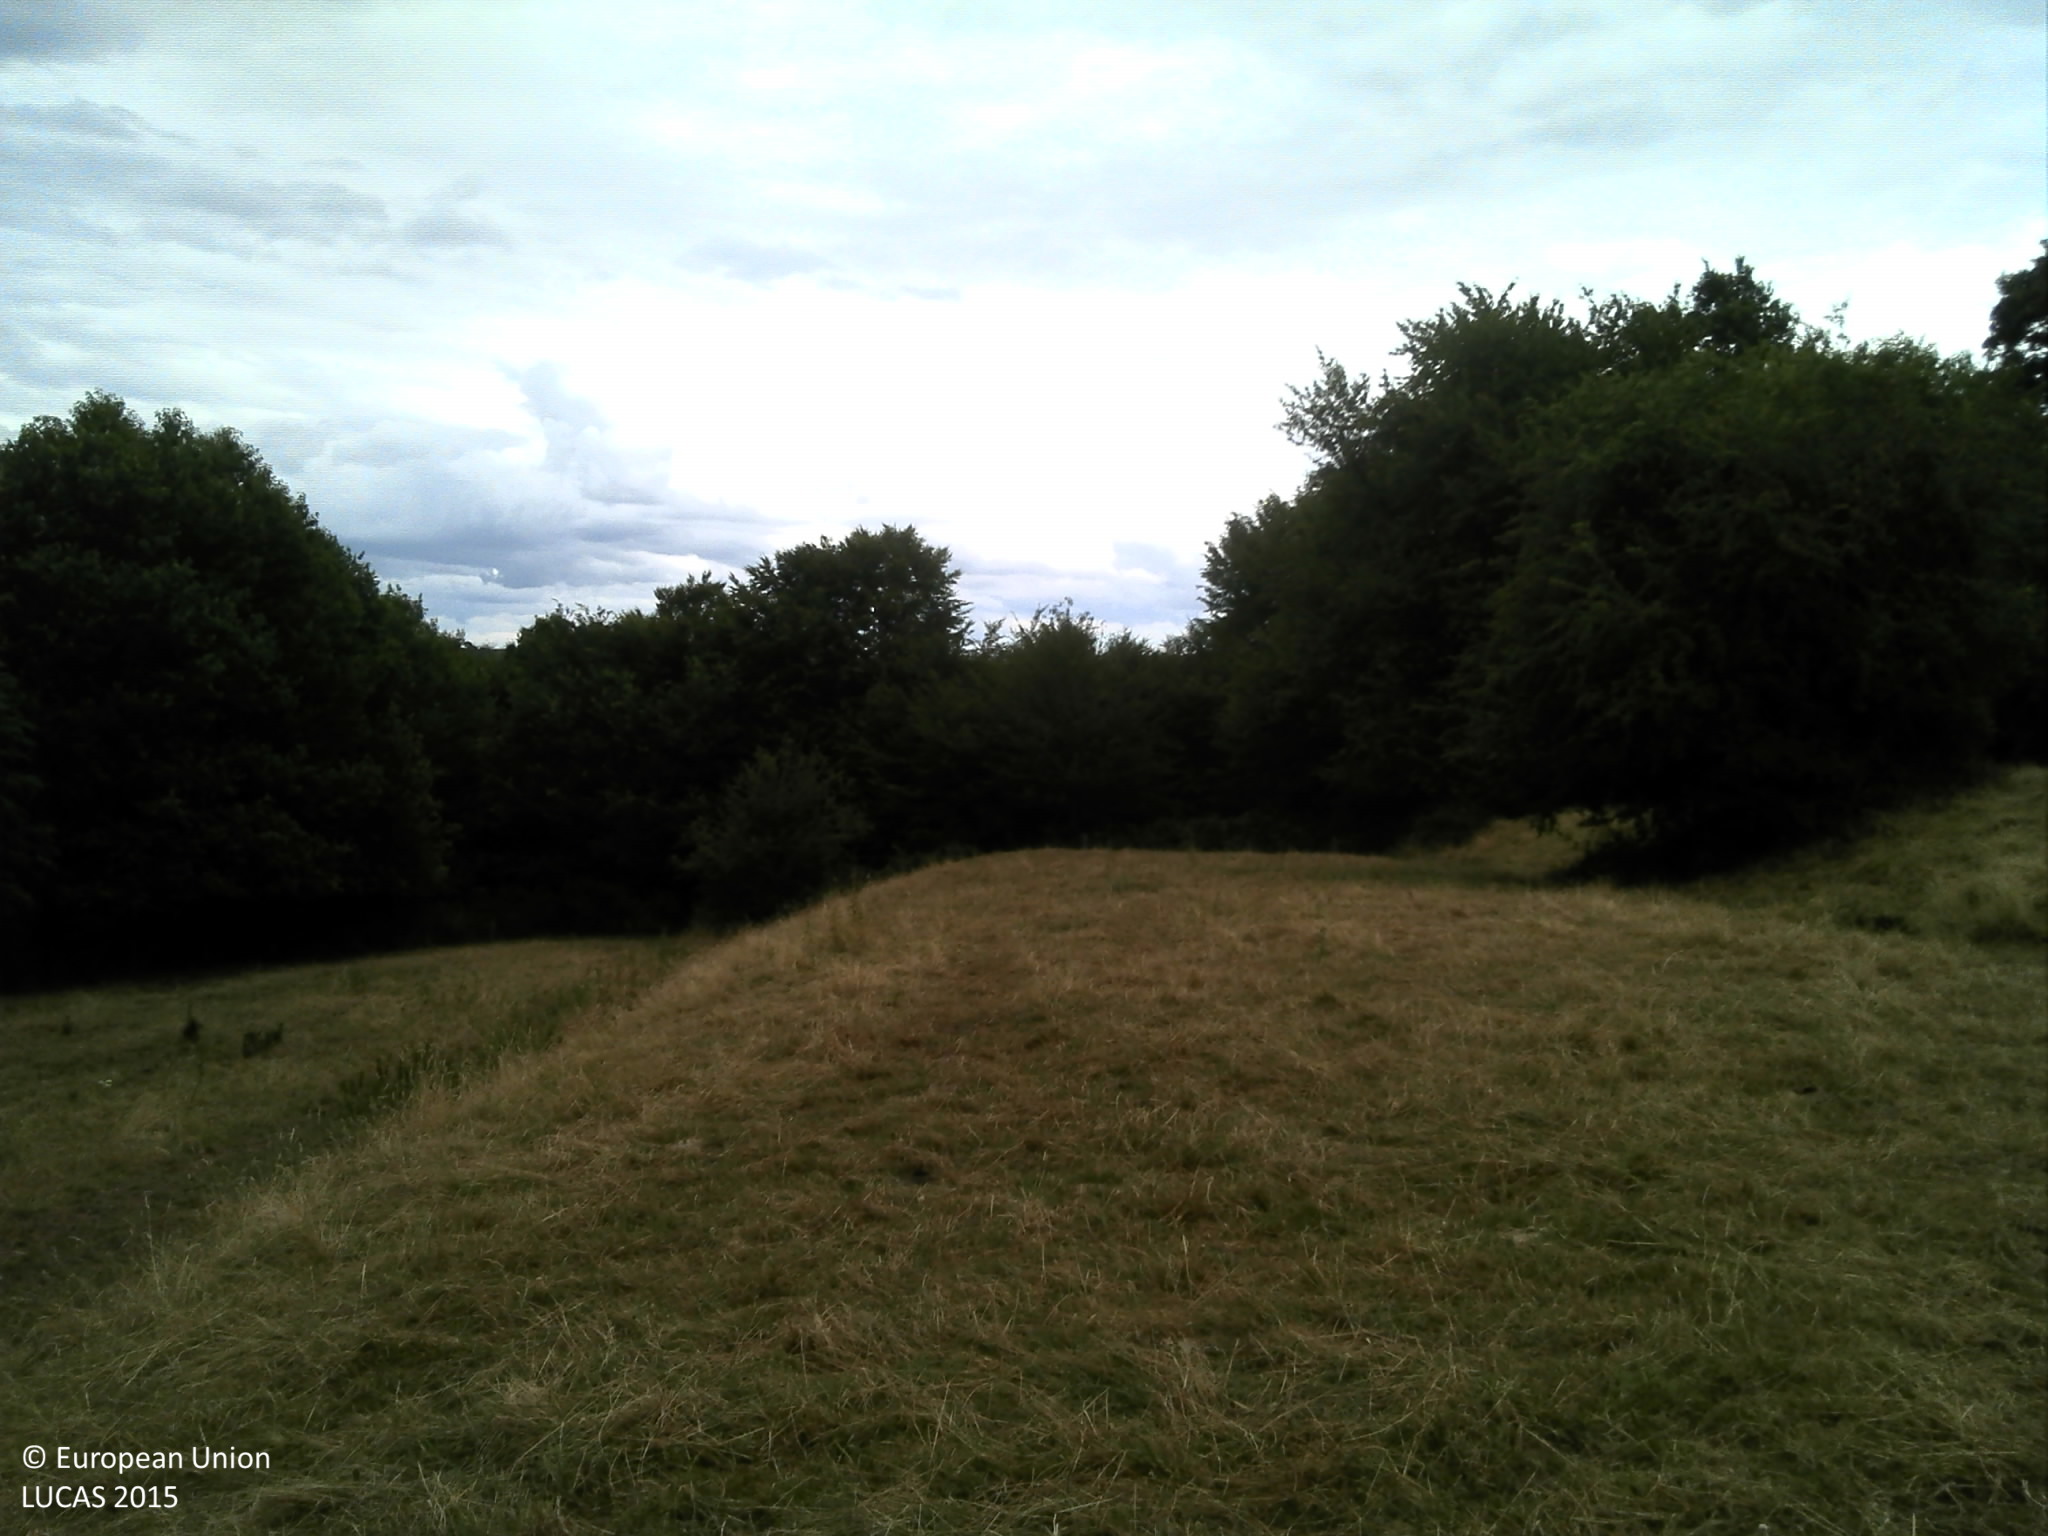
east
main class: Grassland
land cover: Grassland without tree/shrub cover
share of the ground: > 75 %
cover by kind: herbaceous plants 100 %
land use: Agriculture (excluding fallow land and kitchen gardens)
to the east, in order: Grassland without tree/shrub cover; Grassland with sparse tree/shrub cover; Shrubland without tree cover; Fences; Broadleaved woodland; Tracks; Broadleaved woodland; Grassland without tree/shrub cover; Spruce dominated mixed woodland; Tracks; Spruce dominated mixed woodland
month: July
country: FR
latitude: 48.7478
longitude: 7.2670
